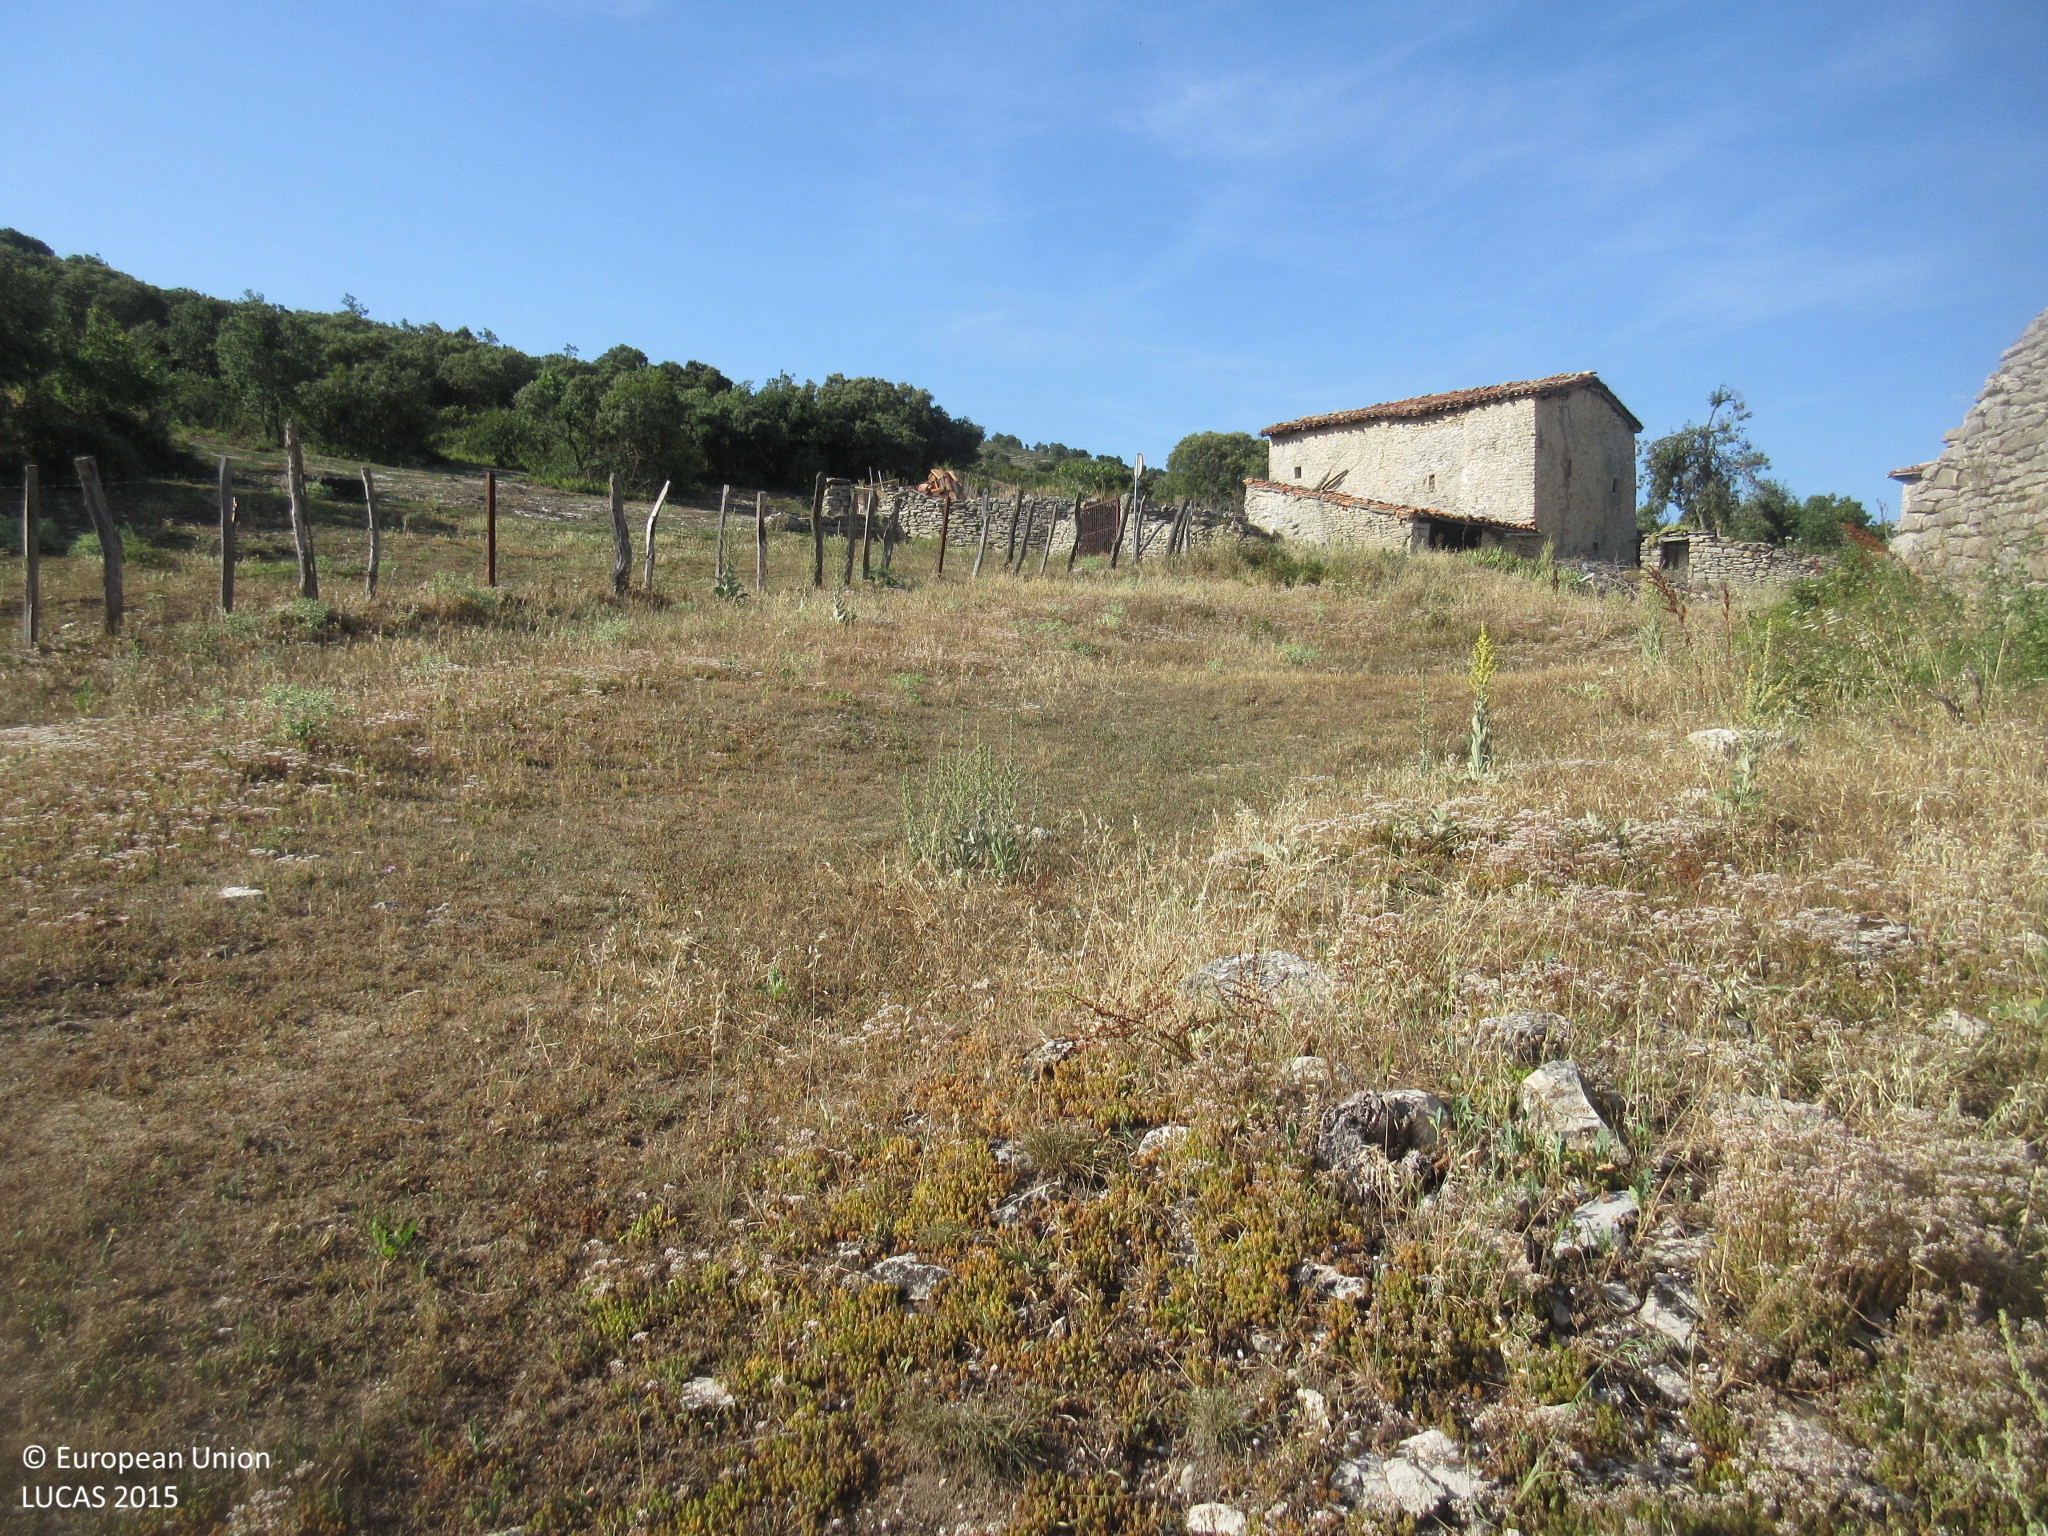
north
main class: Grassland
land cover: Spontaneously vegetated surfaces
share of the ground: > 75 %
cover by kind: herbaceous plants 100 %
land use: Semi-natural and natural areas not in use
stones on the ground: > 50 %
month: July
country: ES
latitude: 43.0523
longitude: -3.4338
